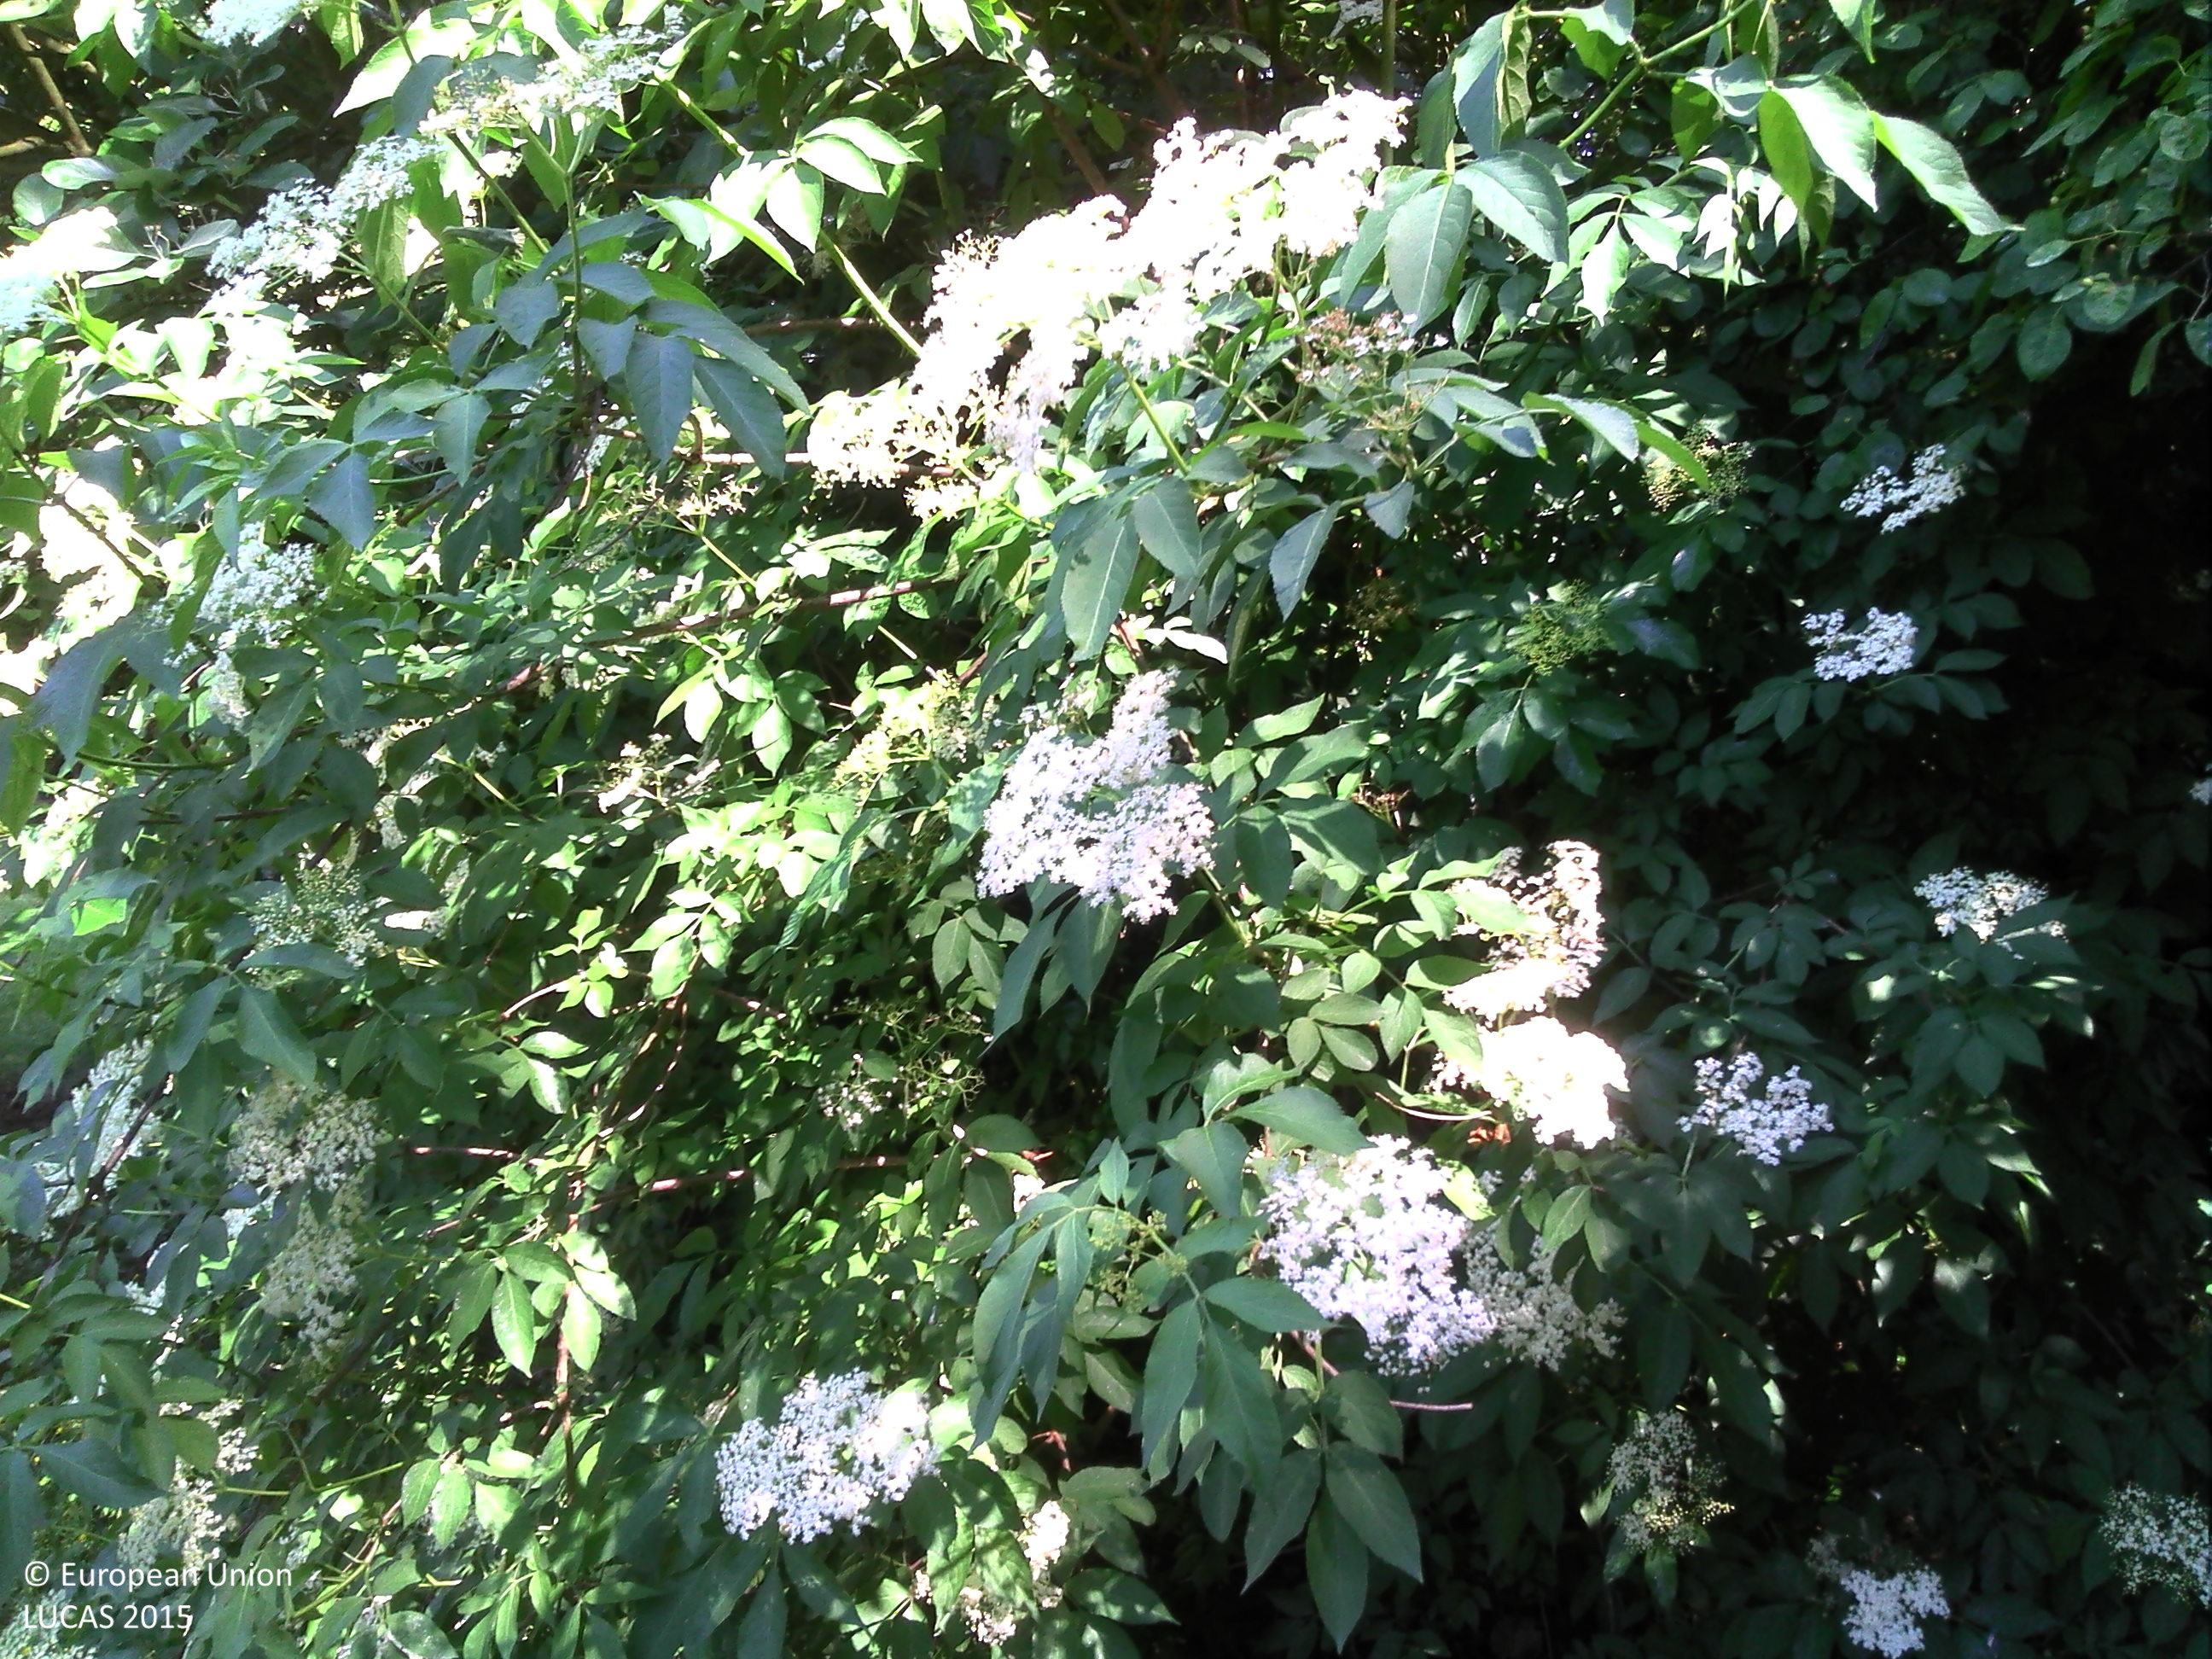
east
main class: Woodland
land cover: Other mixed woodland
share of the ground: > 75 %
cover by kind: broadleaved forest trees 70 %, coniferous forest trees 25 %, herbaceous plants 5 %
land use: Residential
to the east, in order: Other mixed woodland; Artificial constructions in urban areas
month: June
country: BE
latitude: 50.9478
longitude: 5.2008
